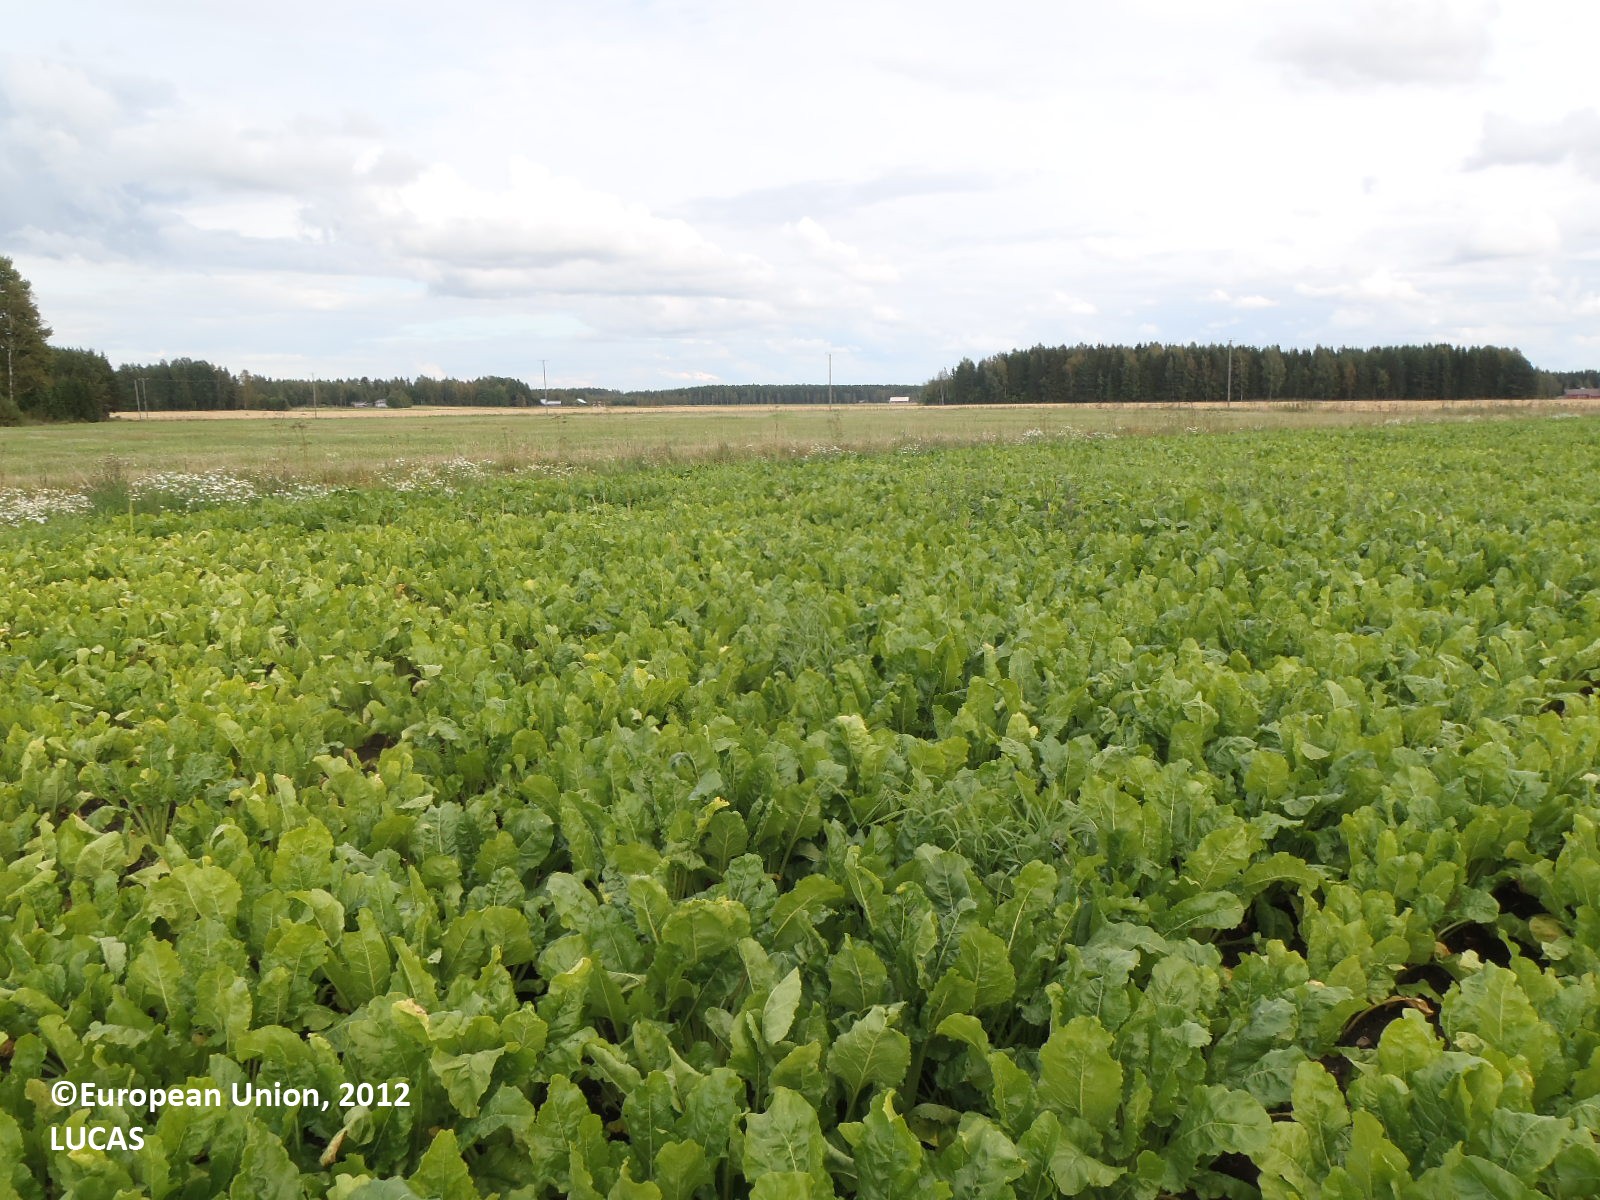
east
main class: Cropland
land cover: Sugar beet
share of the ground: > 75 %
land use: Agriculture (excluding fallow land and kitchen gardens)
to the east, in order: Sugar beet; Grass margins; Ditches and canals; Grass margins; Grassland without tree/shrub cover; Electric lines; Grassland without tree/shrub cover
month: August
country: FI
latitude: 60.6553
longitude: 22.3787
